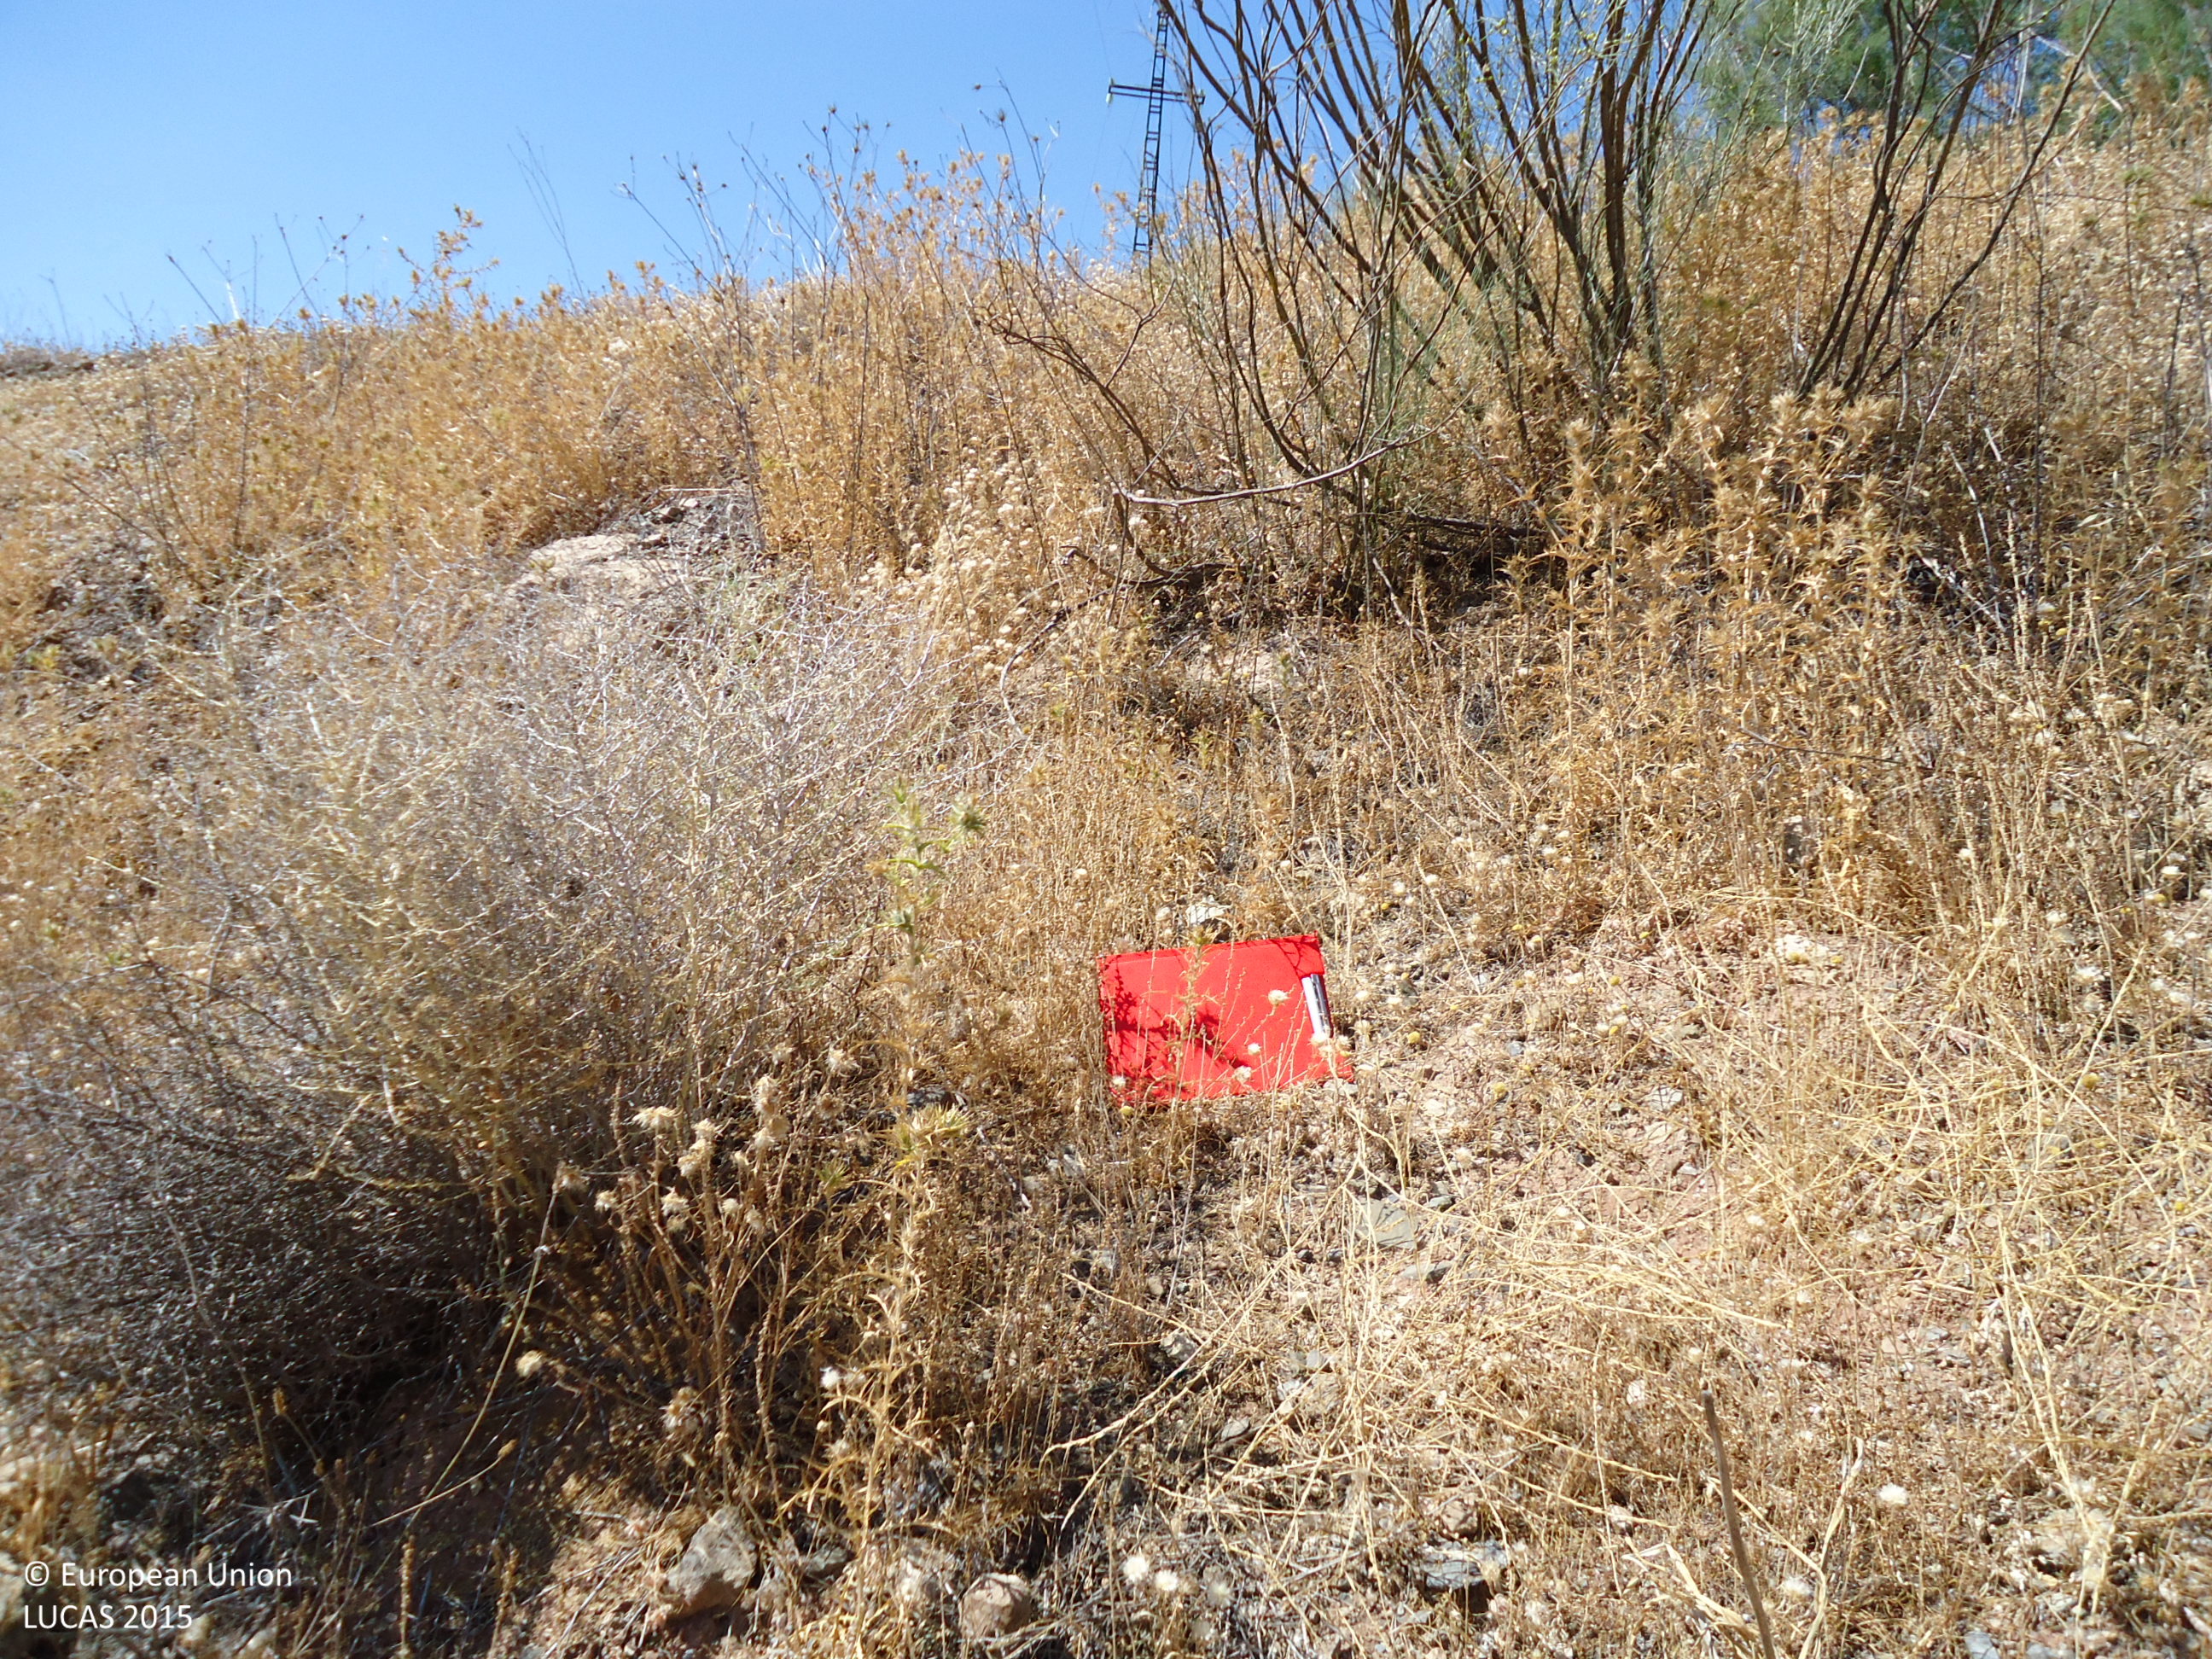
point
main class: Shrubland
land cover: Shrubland without tree cover
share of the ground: > 75 %
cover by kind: shrubs 95 %, herbaceous plants 5 %
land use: Agriculture (excluding fallow land and kitchen gardens)
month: June
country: ES
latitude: 36.7492
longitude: -4.6769
